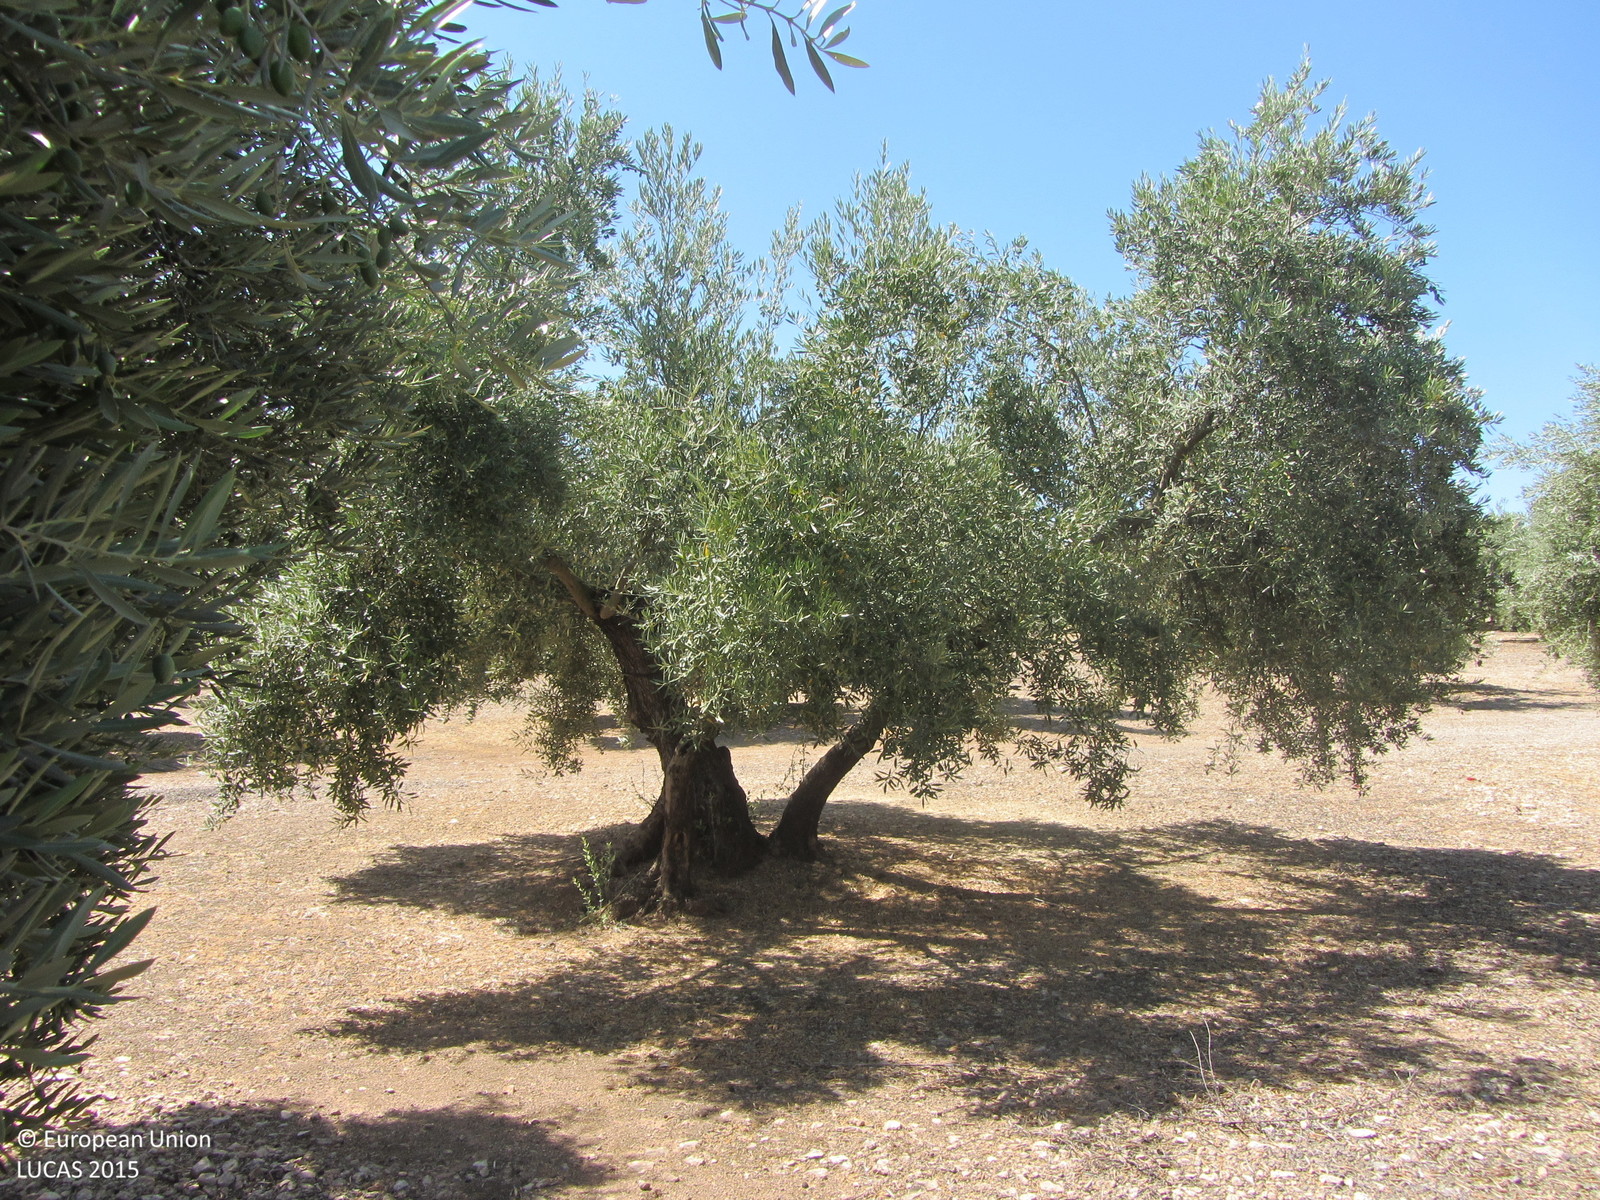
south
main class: Cropland
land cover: Olive groves
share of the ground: 50 - 75 %
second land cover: Other bare soil
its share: > 75 %
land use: Agriculture (excluding fallow land and kitchen gardens)
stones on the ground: 10 - 25 %
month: July
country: ES
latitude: 37.9827
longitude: -3.8145
